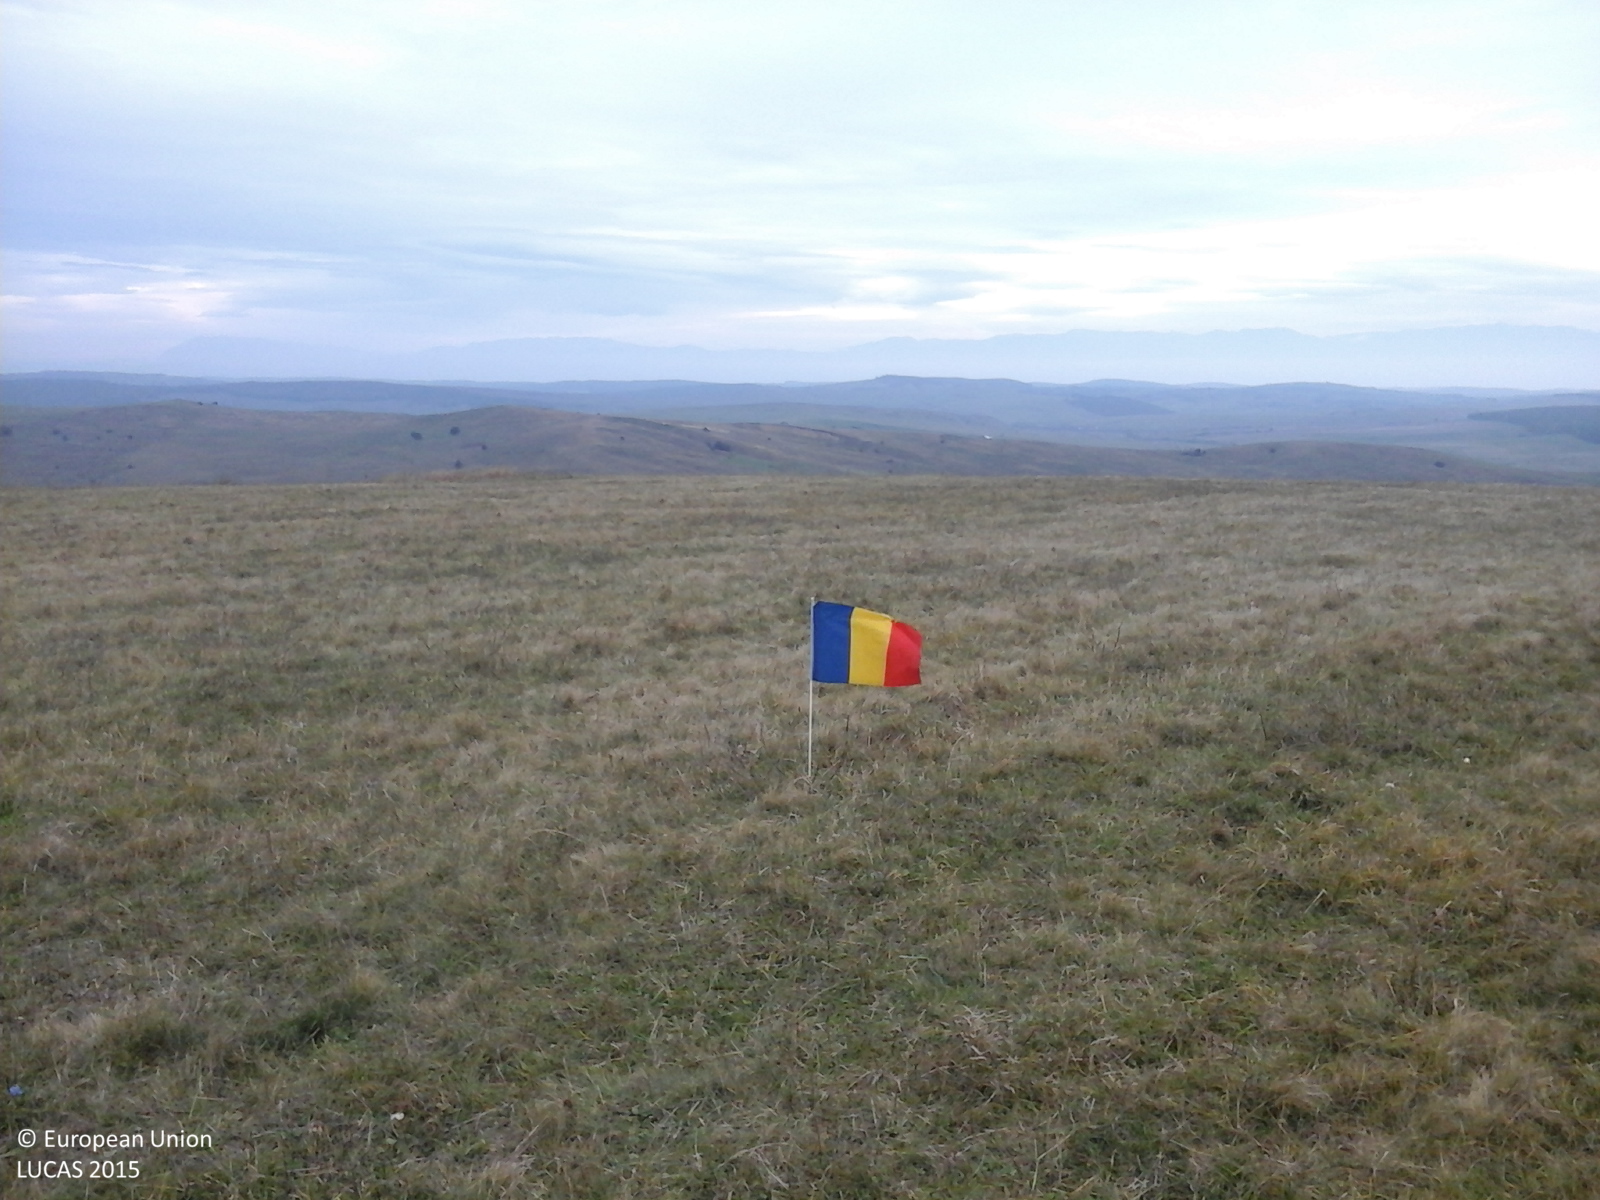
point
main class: Grassland
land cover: Grassland without tree/shrub cover
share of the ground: > 75 %
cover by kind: herbaceous plants 100 %
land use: Agriculture (excluding fallow land and kitchen gardens)
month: October
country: RO
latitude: 46.0377
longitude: 24.9920
